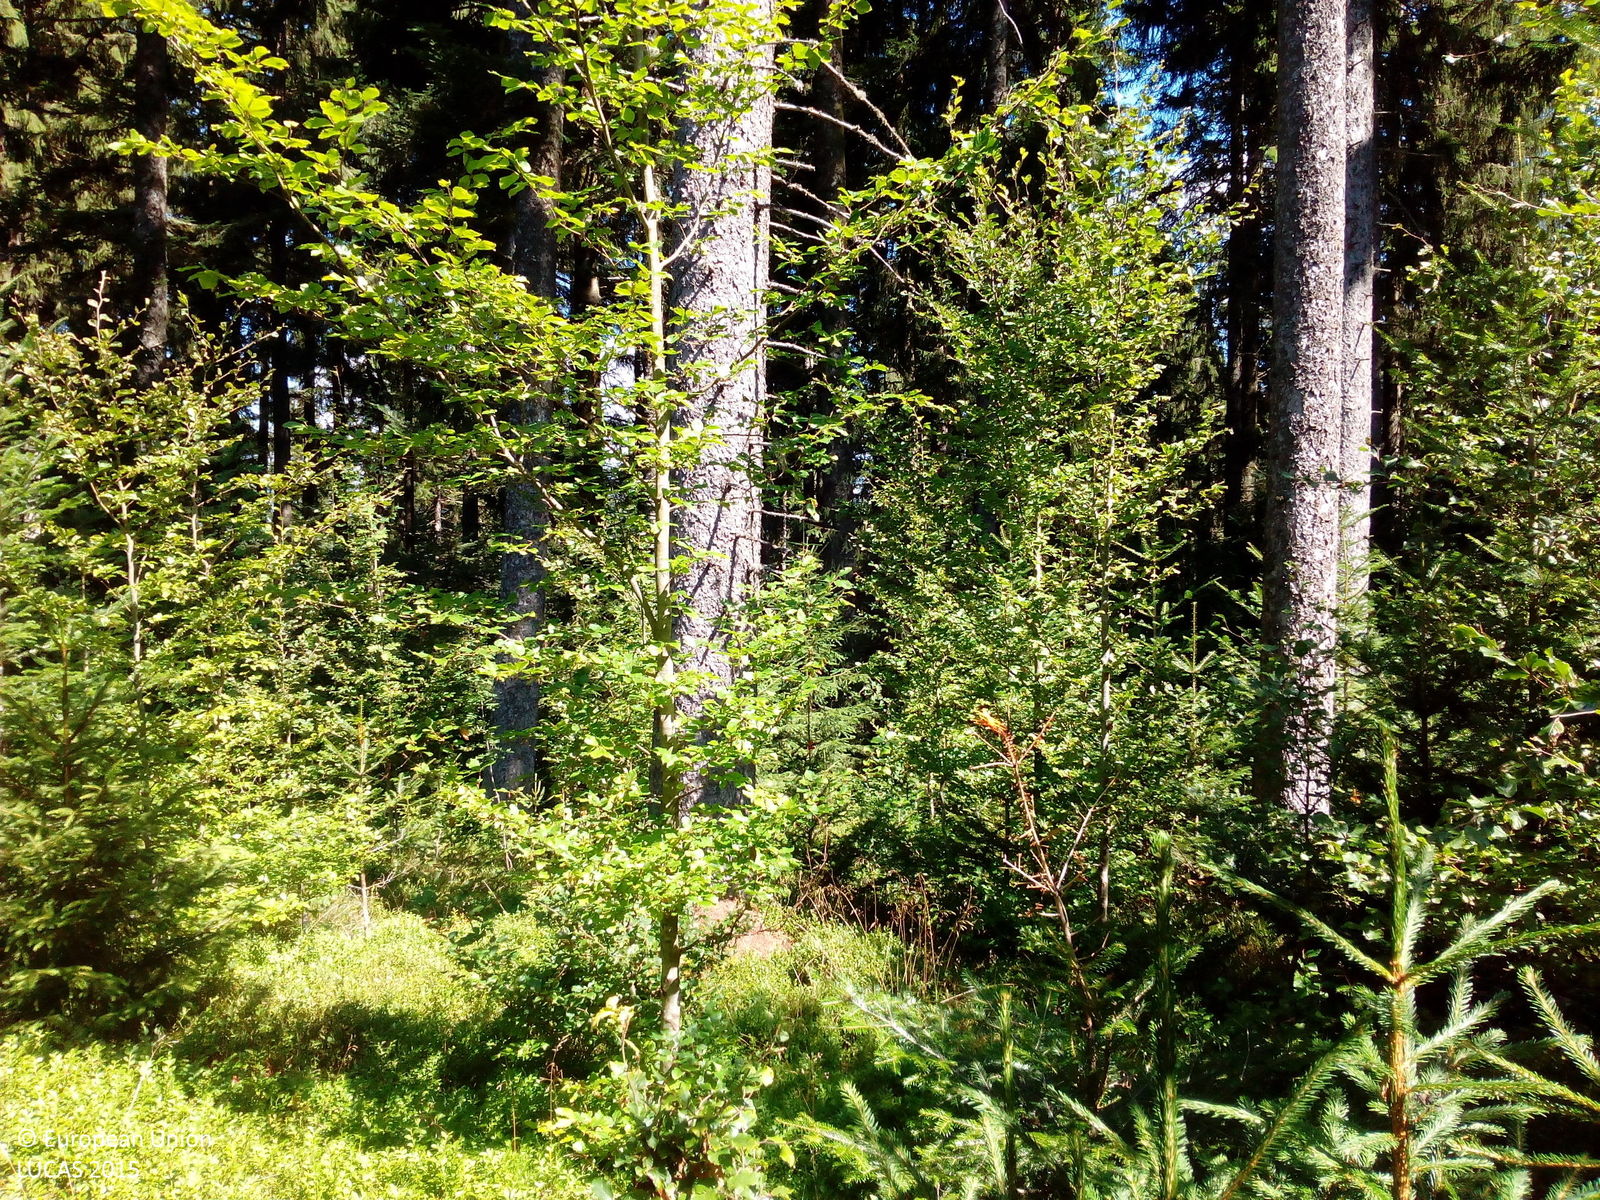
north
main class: Woodland
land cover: Other mixed woodland
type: beech forest
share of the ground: 50 - 75 %
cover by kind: broadleaved forest trees 40 %, coniferous forest trees 30 %, shrubs 10 %, unconsolidated bare surface 10 %, herbaceous plants 5 %, lichens and mosses 5 %
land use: Forestry
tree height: > 5 m
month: August
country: DE
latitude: 47.9743
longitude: 8.1659
